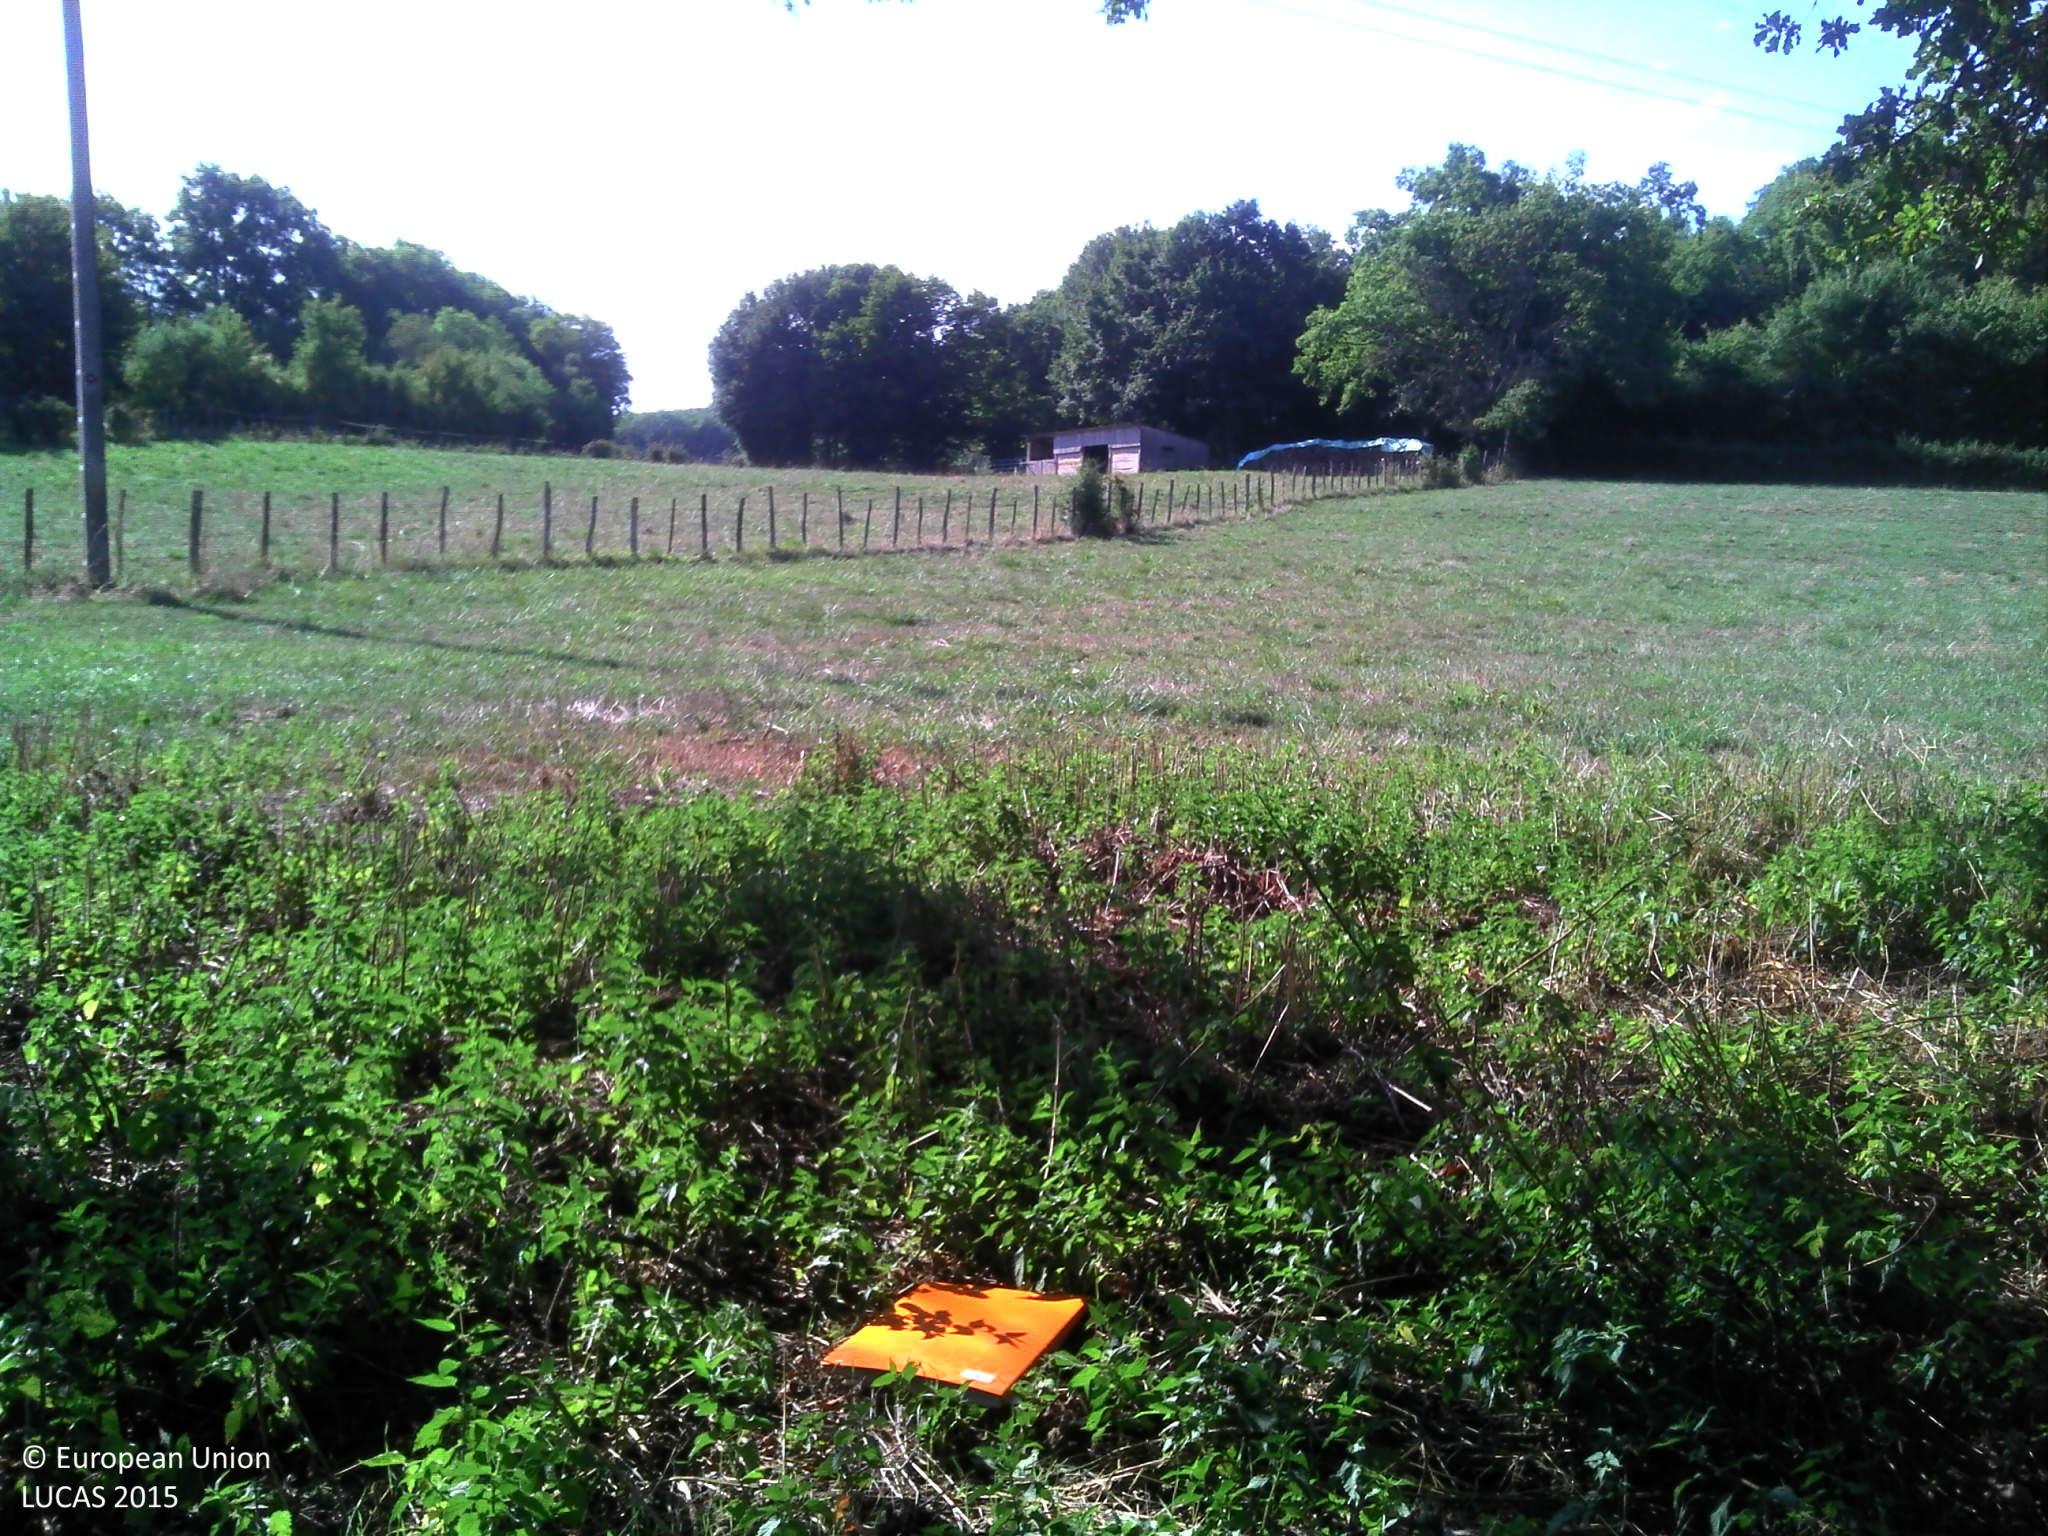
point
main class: Grassland
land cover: Grassland with sparse tree/shrub cover
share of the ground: > 75 %
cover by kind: herbaceous plants 95 %, broadleaved forest trees 5 %
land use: Agriculture (excluding fallow land and kitchen gardens)
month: August
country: FR
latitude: 46.3686
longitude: 4.7895
